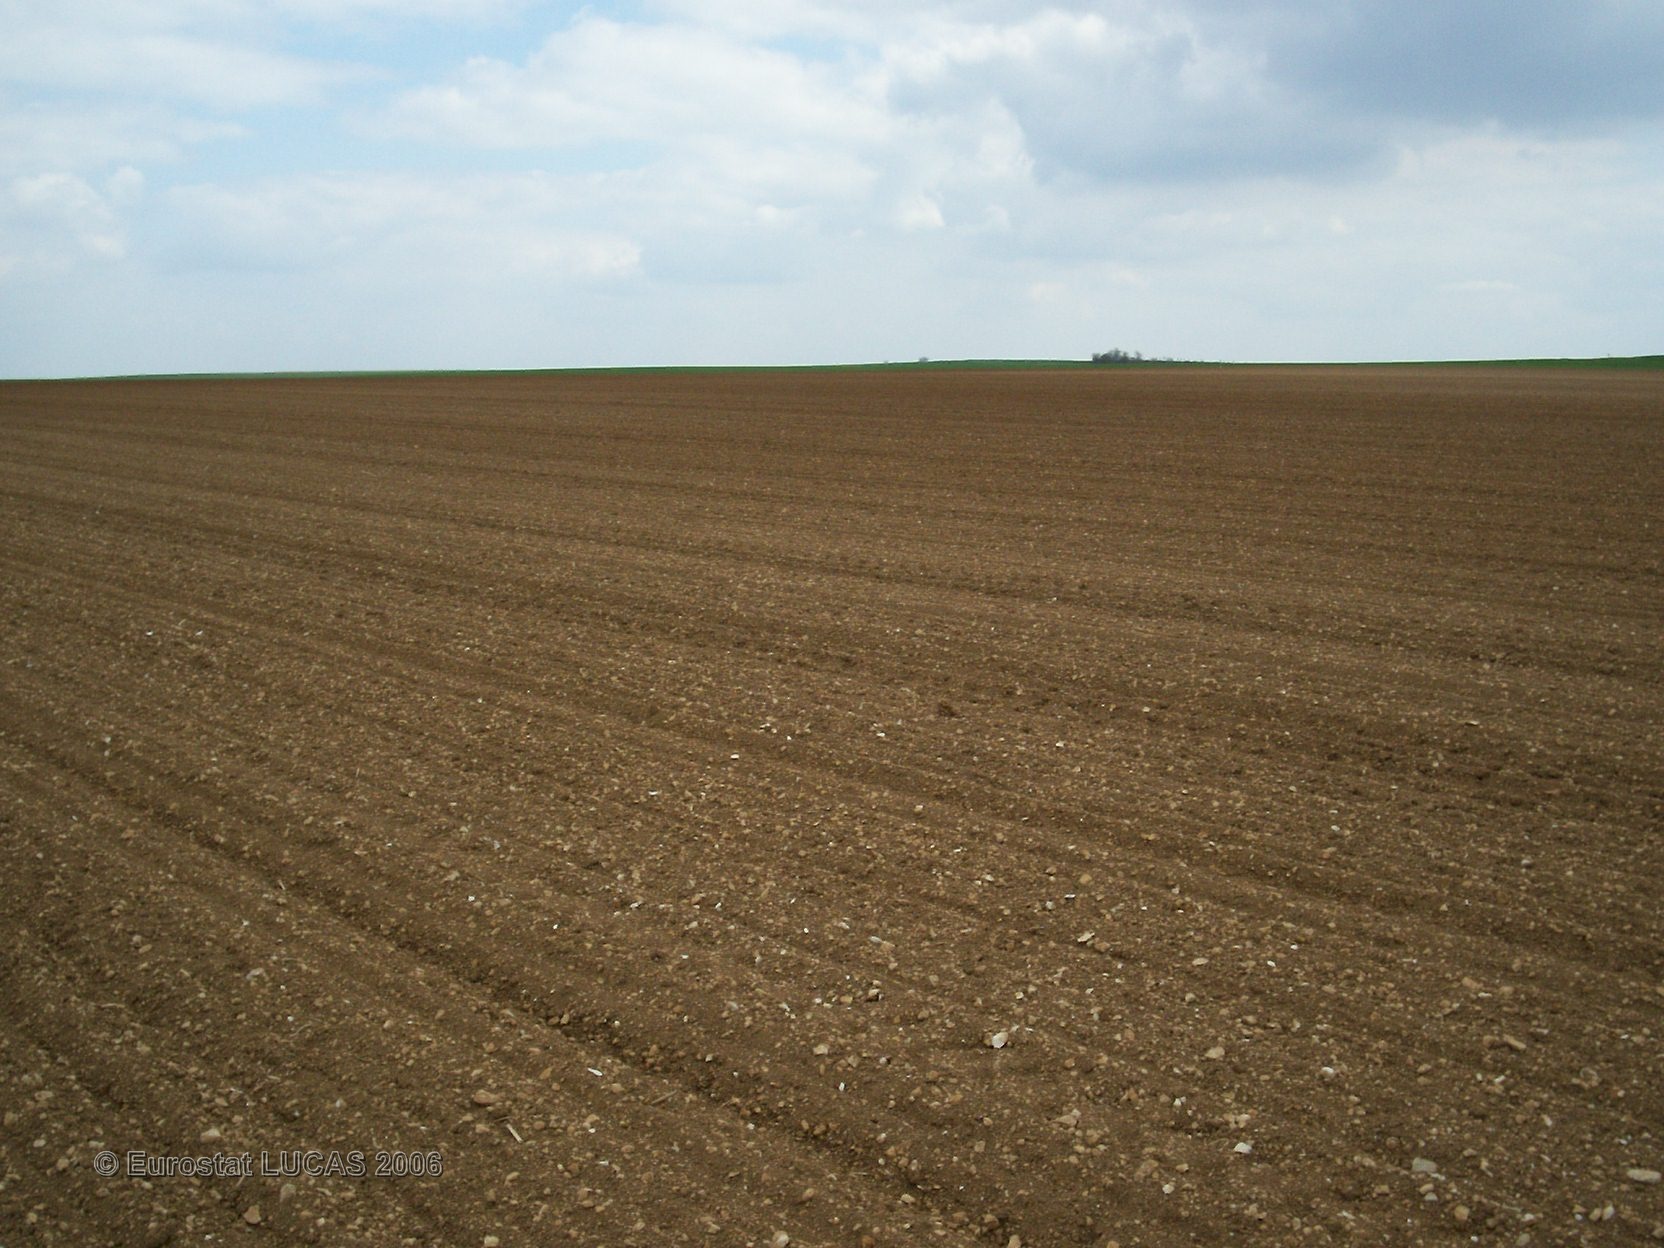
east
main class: Cropland
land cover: Sugar beet
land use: Agriculture (excluding fallow land and kitchen gardens)
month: April
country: FR
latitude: 48.5019
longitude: 4.5159
